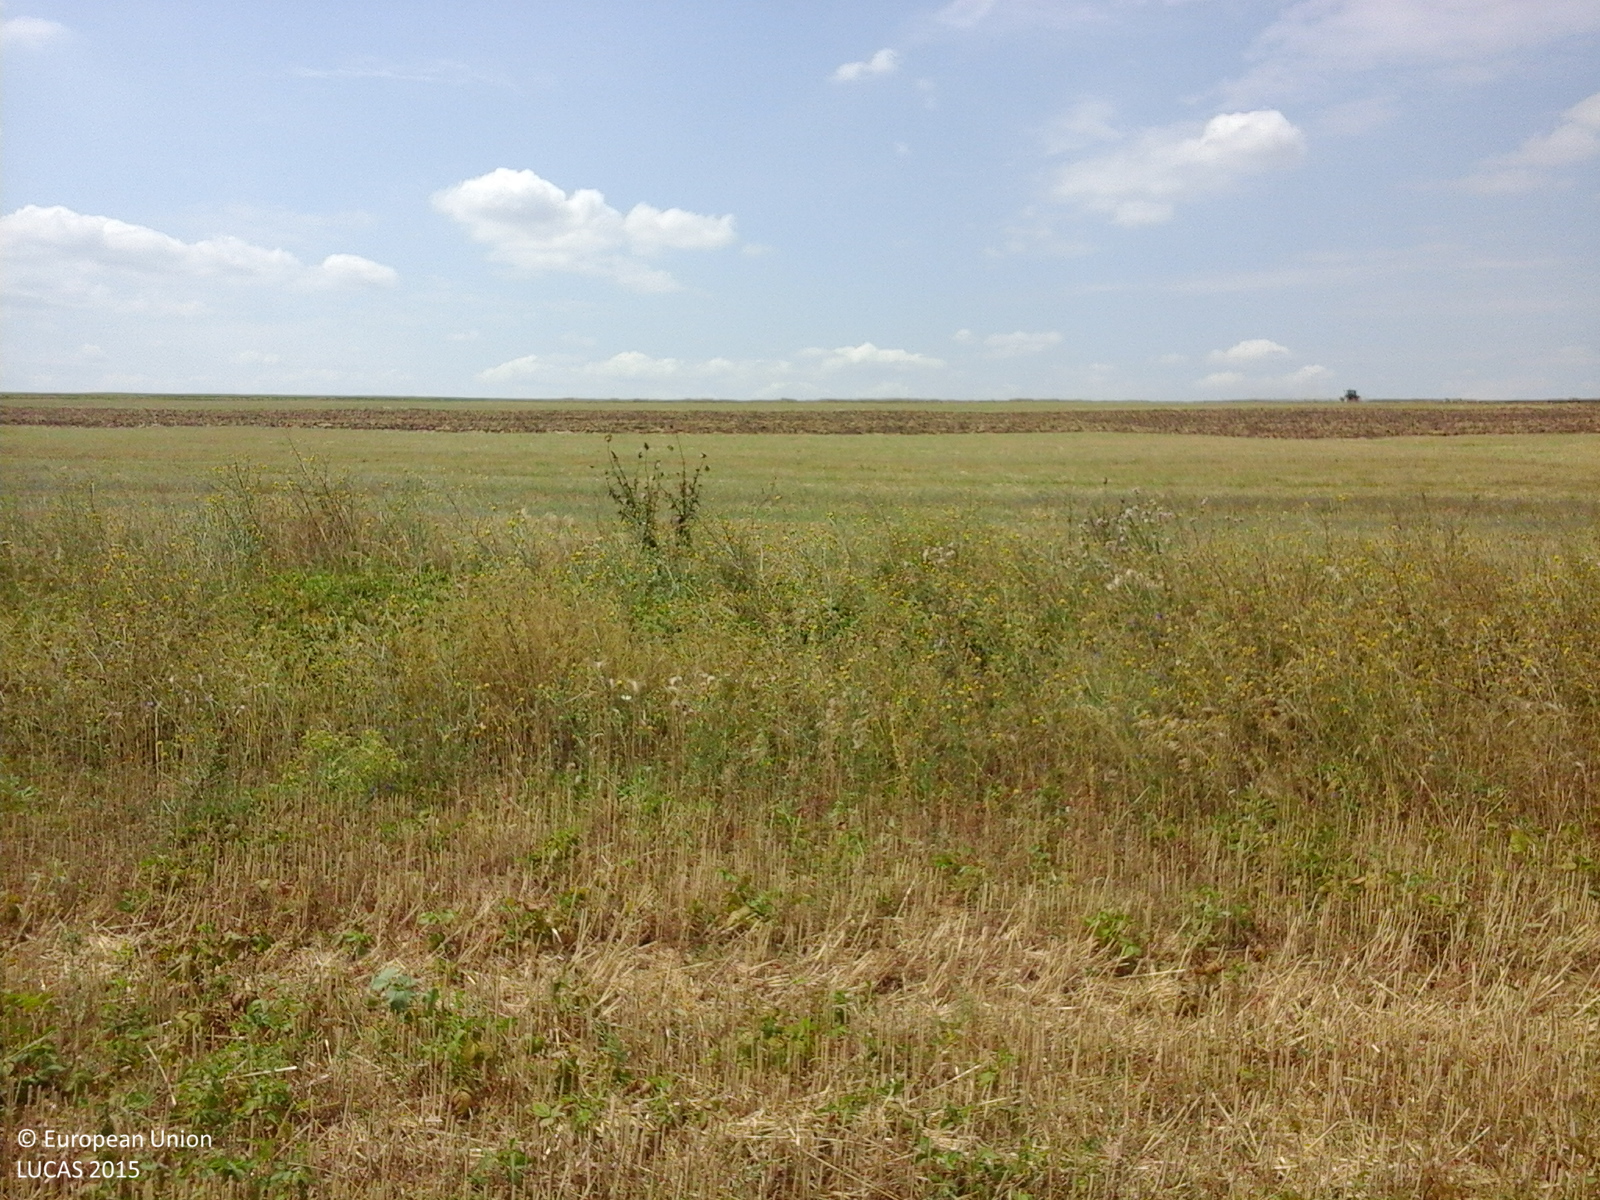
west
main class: Cropland
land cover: Common wheat
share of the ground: > 75 %
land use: Agriculture (excluding fallow land and kitchen gardens)
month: August
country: RO
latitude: 44.6718
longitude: 28.5564
